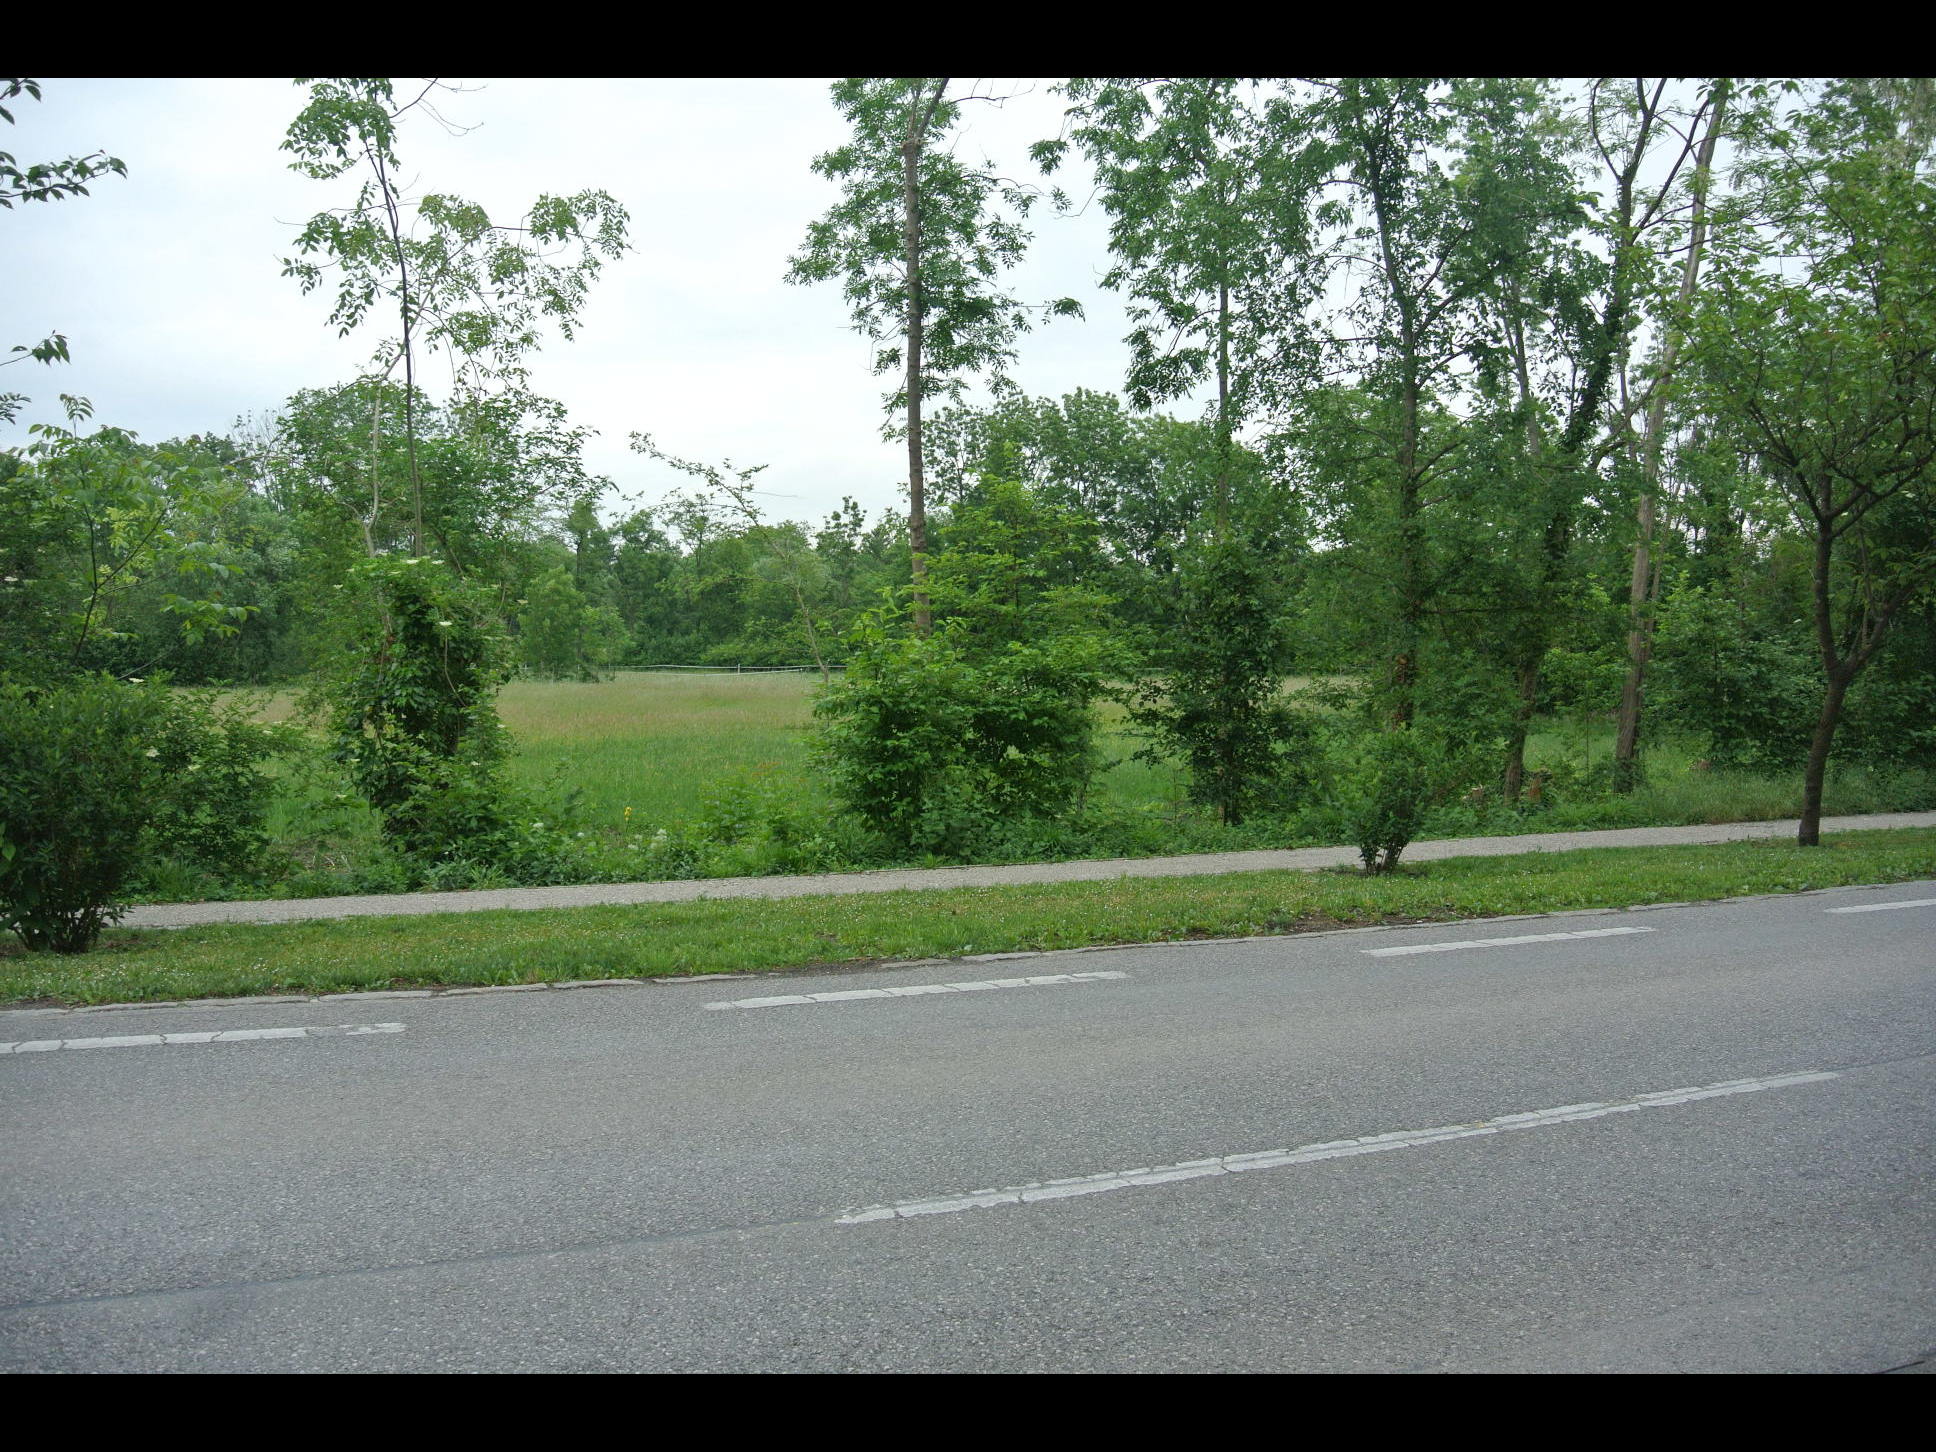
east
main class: Woodland
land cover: Broadleaved woodland
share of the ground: > 75 %
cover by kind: broadleaved forest trees 85 %, shrubs 15 %
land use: Semi-natural and natural areas not in use
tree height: > 5 m
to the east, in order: Broadleaved woodland; Grass margins; Paved roads, cycling and walking lanes; Shrubland with sparse tree cover; Grassland without tree/shrub cover; Fences; Other mixed woodland; Fences; Grassland without tree/shrub cover; Broadleaved woodland; Inland fresh running water; Broadleaved woodland; Grassland without tree/shrub cover; Broadleaved woodland; Grassland without tree/shrub cover
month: May
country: AT
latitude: 48.0164
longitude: 16.4536
